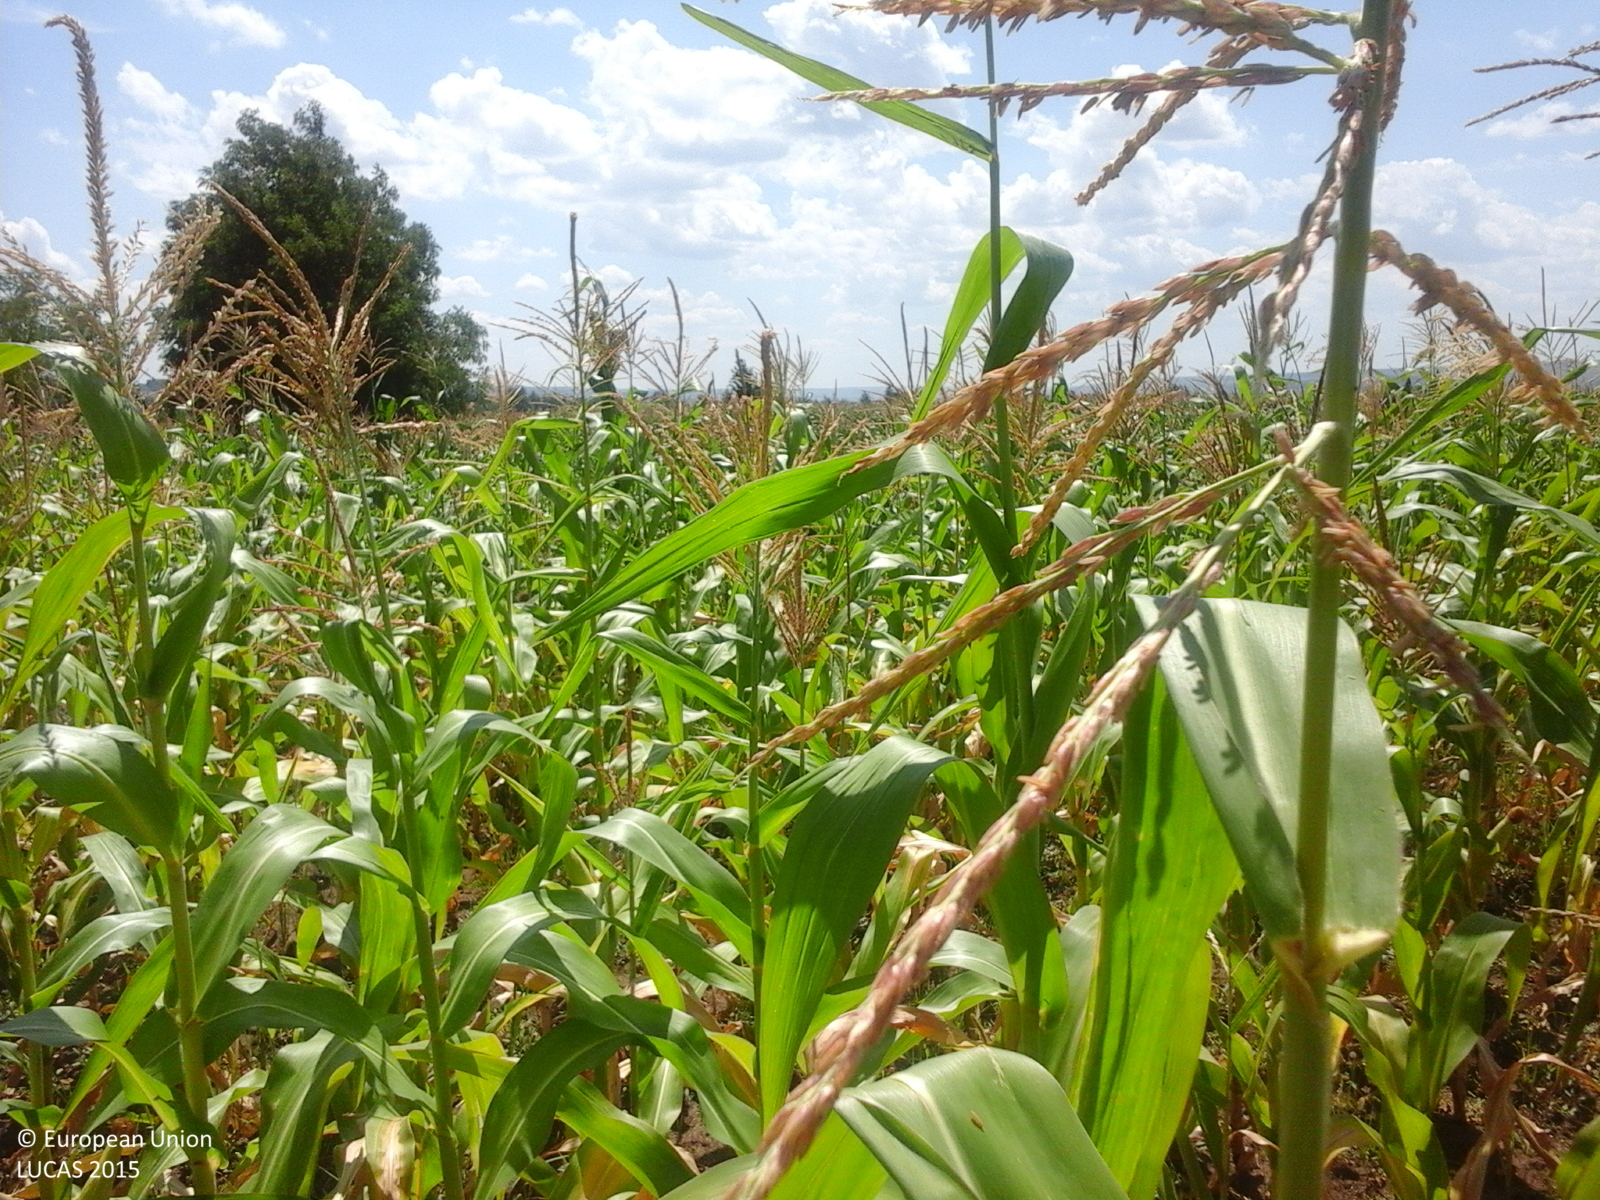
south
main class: Cropland
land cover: Maize
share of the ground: > 75 %
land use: Agriculture (excluding fallow land and kitchen gardens)
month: July
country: RO
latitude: 46.5095
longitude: 27.8592
